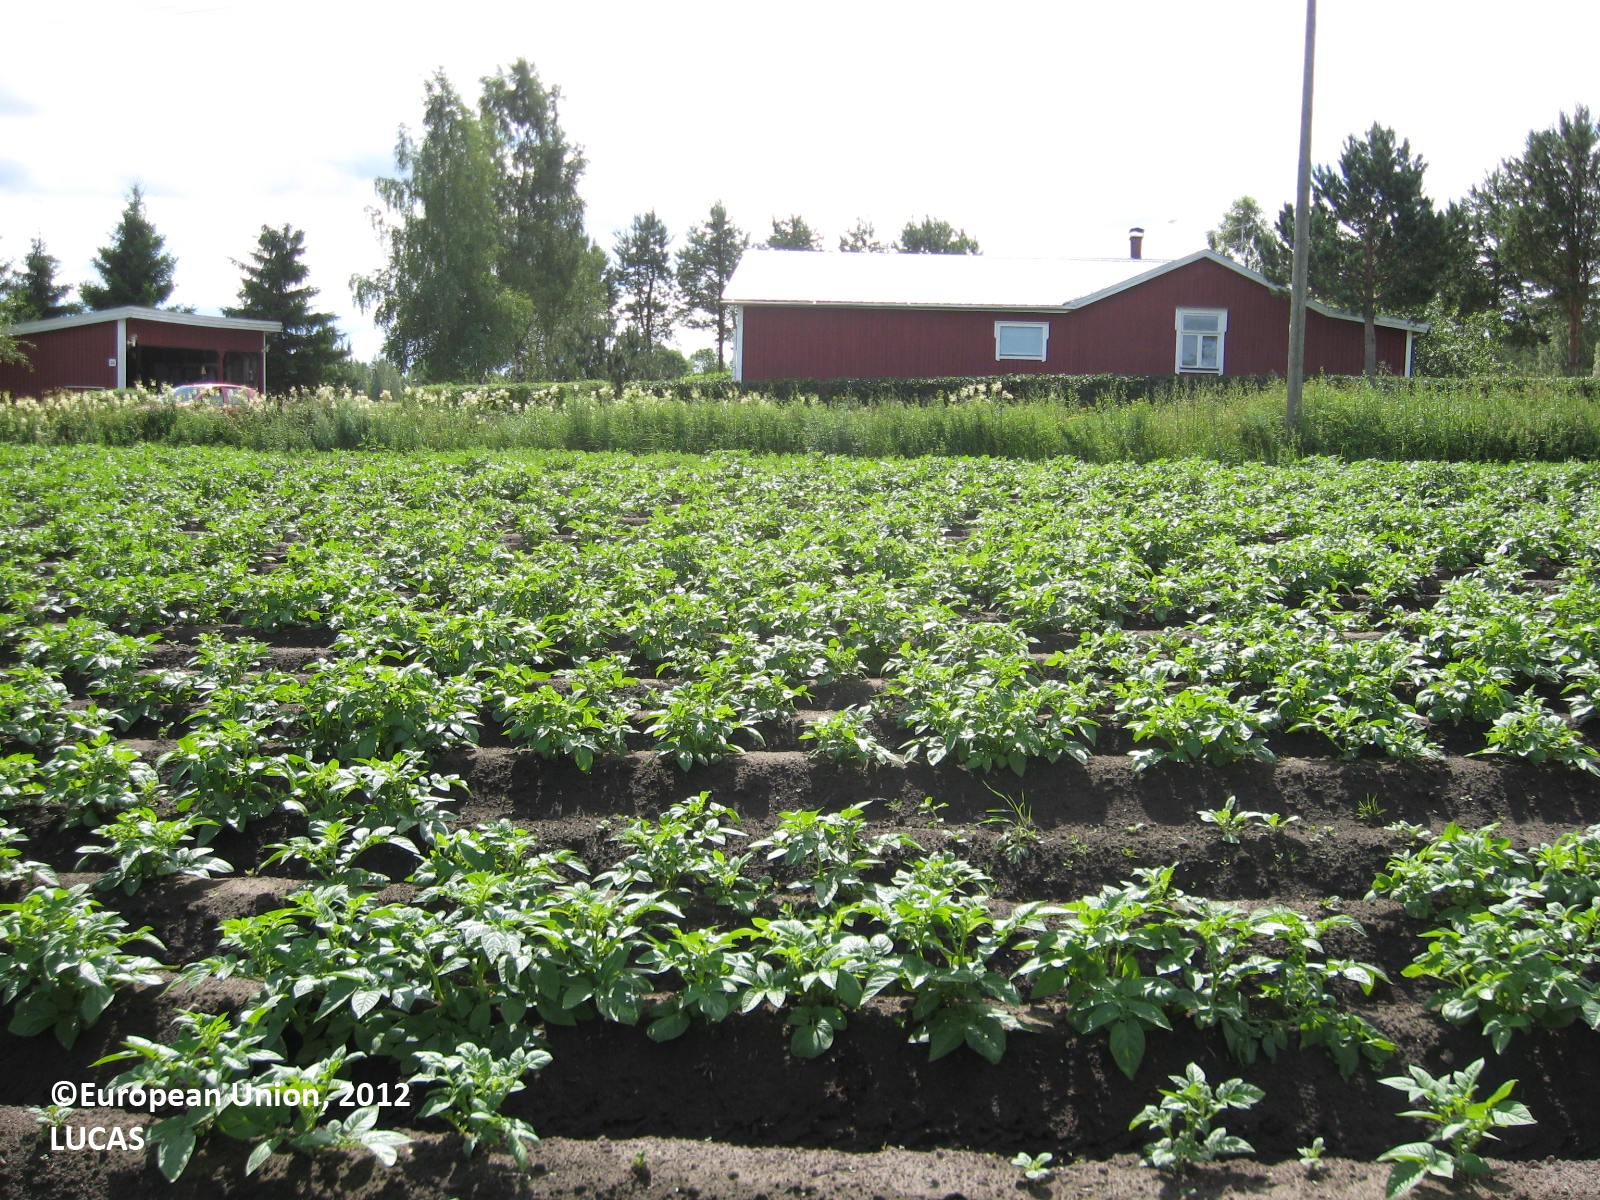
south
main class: Cropland
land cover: Potatoes
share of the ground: 50 - 75 %
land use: Agriculture (excluding fallow land and kitchen gardens)
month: July
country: FI
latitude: 62.3854
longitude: 21.5511
